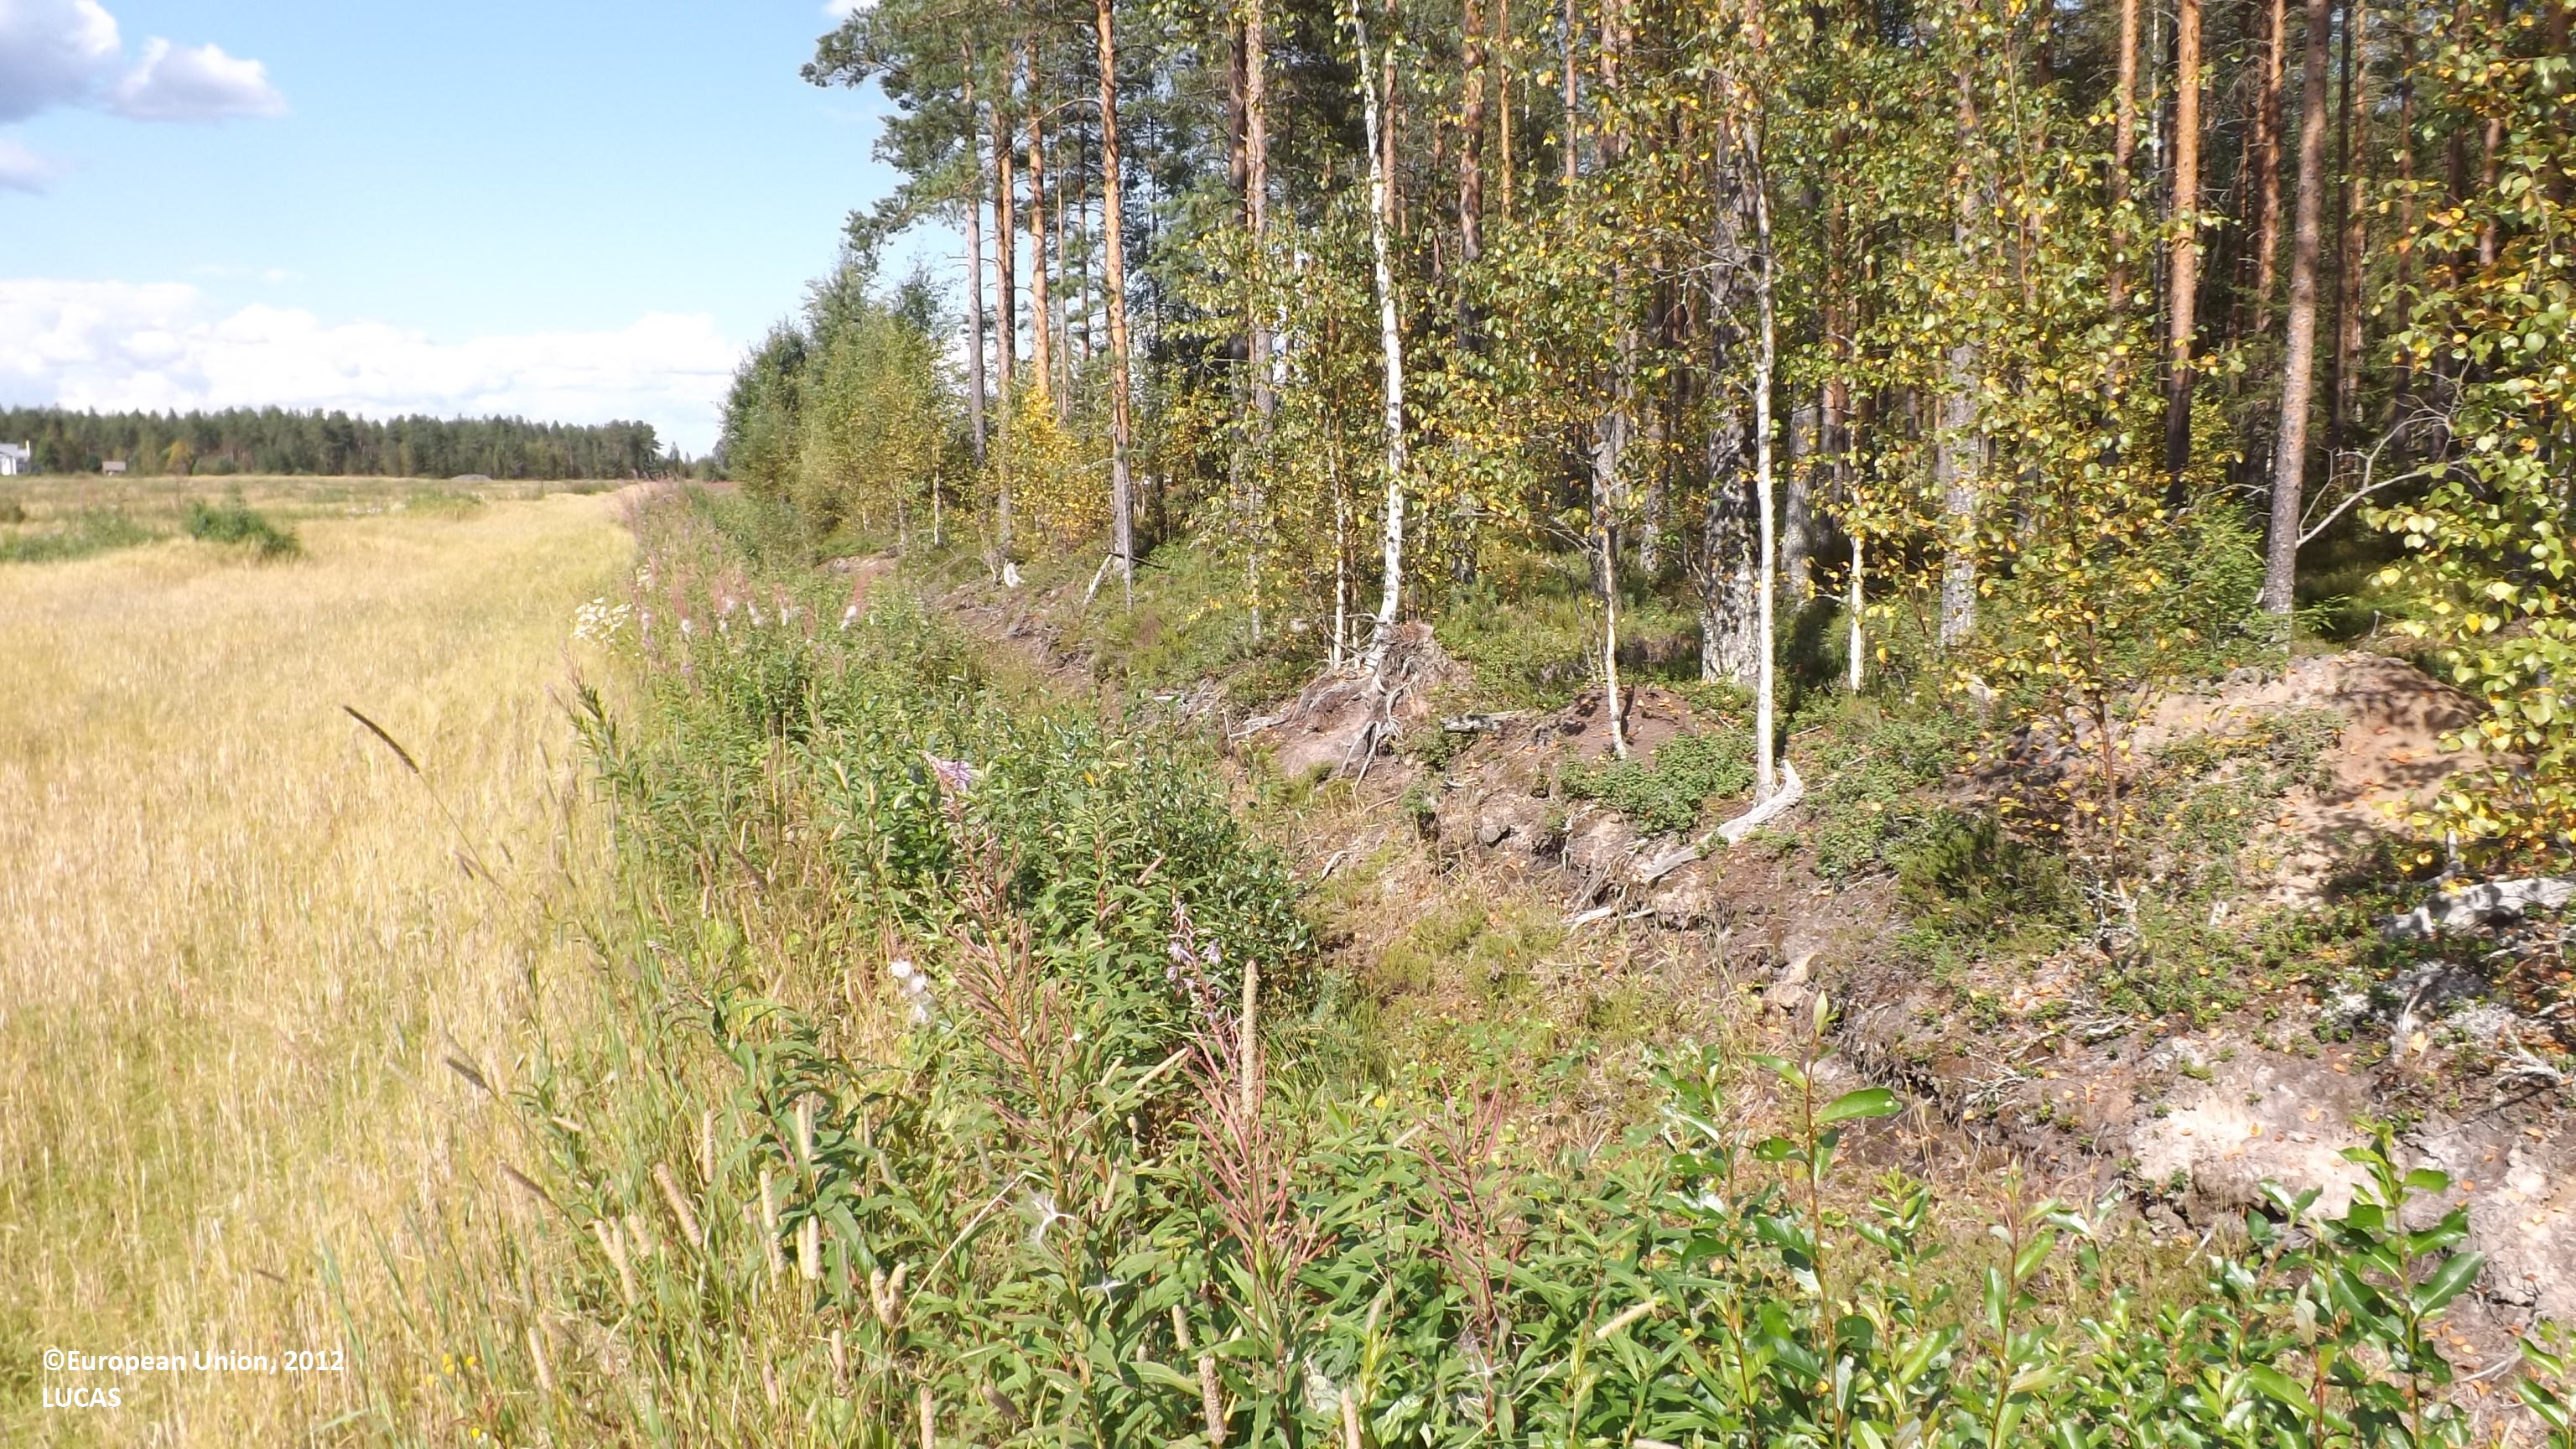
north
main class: Cropland
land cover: Barley
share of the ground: > 75 %
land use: Agriculture (excluding fallow land and kitchen gardens)
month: August
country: FI
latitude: 63.2050
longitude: 24.3764
